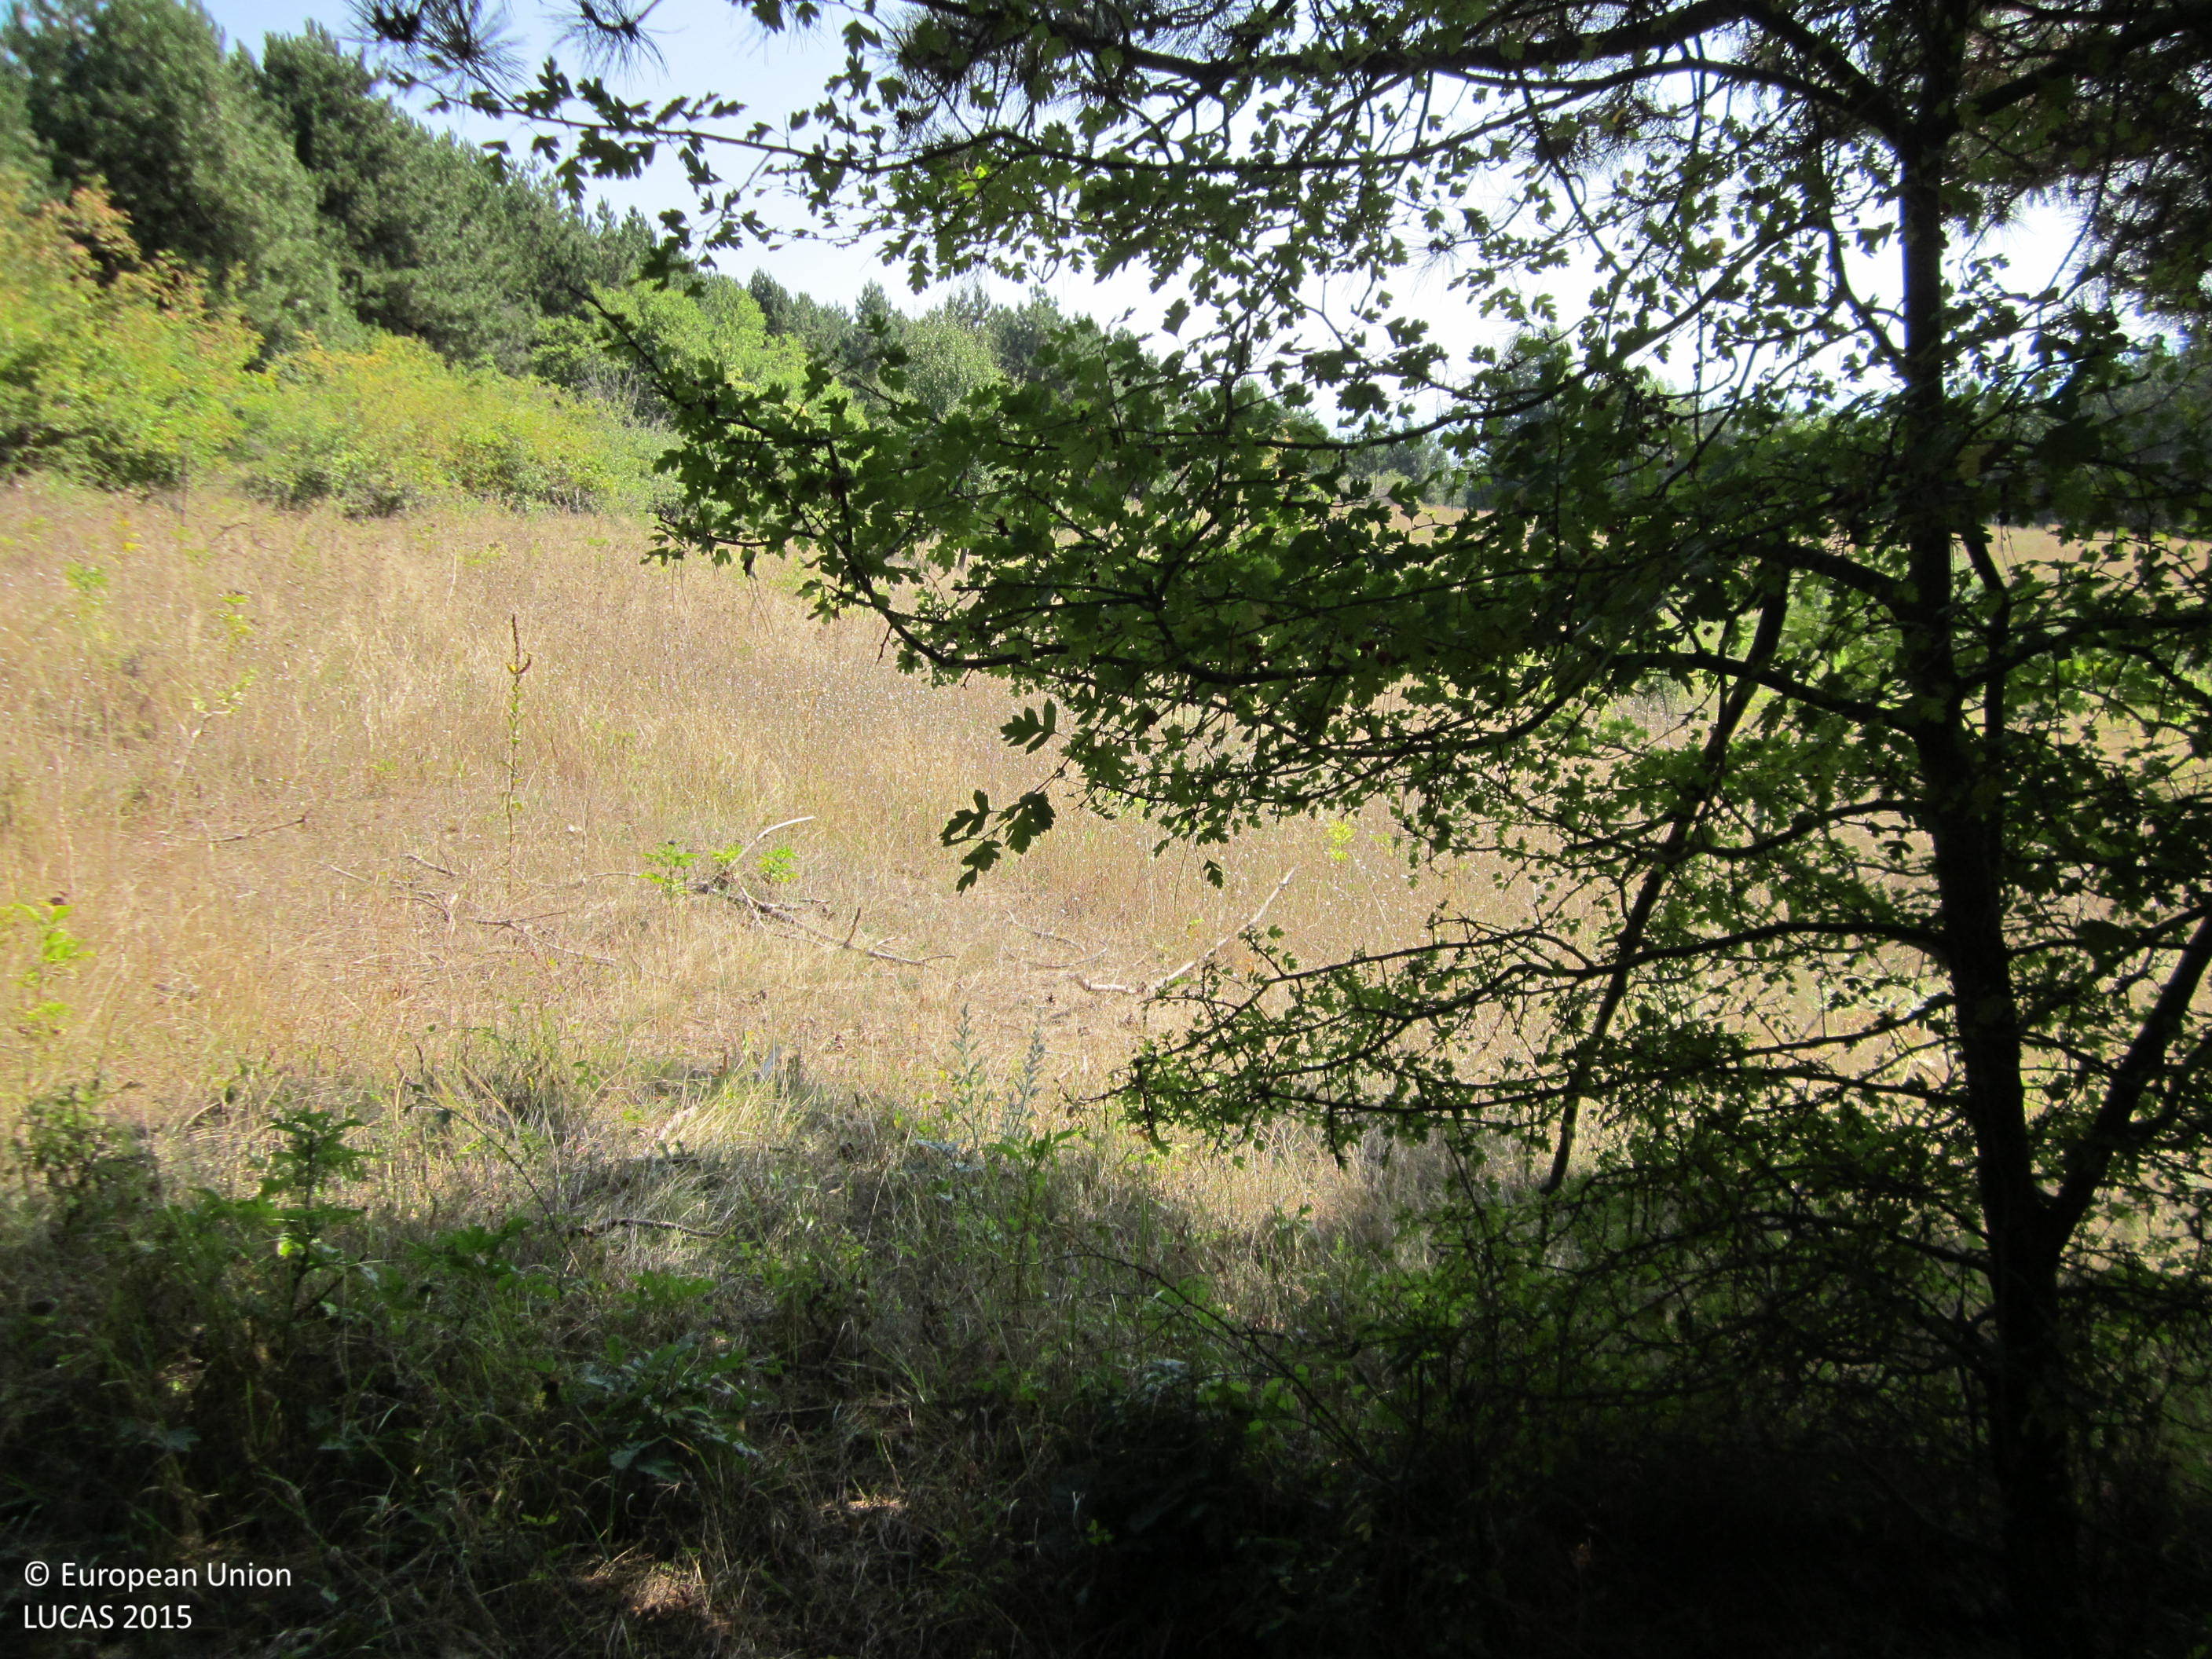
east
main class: Woodland
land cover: Pine dominated coniferous woodland
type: hemiboreal forest and nemoral coniferous forest and mixed broadleaved-coniferous forest
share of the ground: > 75 %
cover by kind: coniferous forest trees 90 %, unconsolidated bare surface 10 %
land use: Forestry
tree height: > 5 m
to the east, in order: Pine dominated coniferous woodland; Groves; Grassland without tree/shrub cover; Single bushes/trees; Grassland without tree/shrub cover; Tracks; Grassland without tree/shrub cover; Ditches and canals; Grass margins; Paved roads, cycling and walking lanes; Grass margins; Ditches and canals; Broadleaved woodland; Grassland without tree/shrub cover
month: September
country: BG
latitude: 42.8542
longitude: 26.9347
